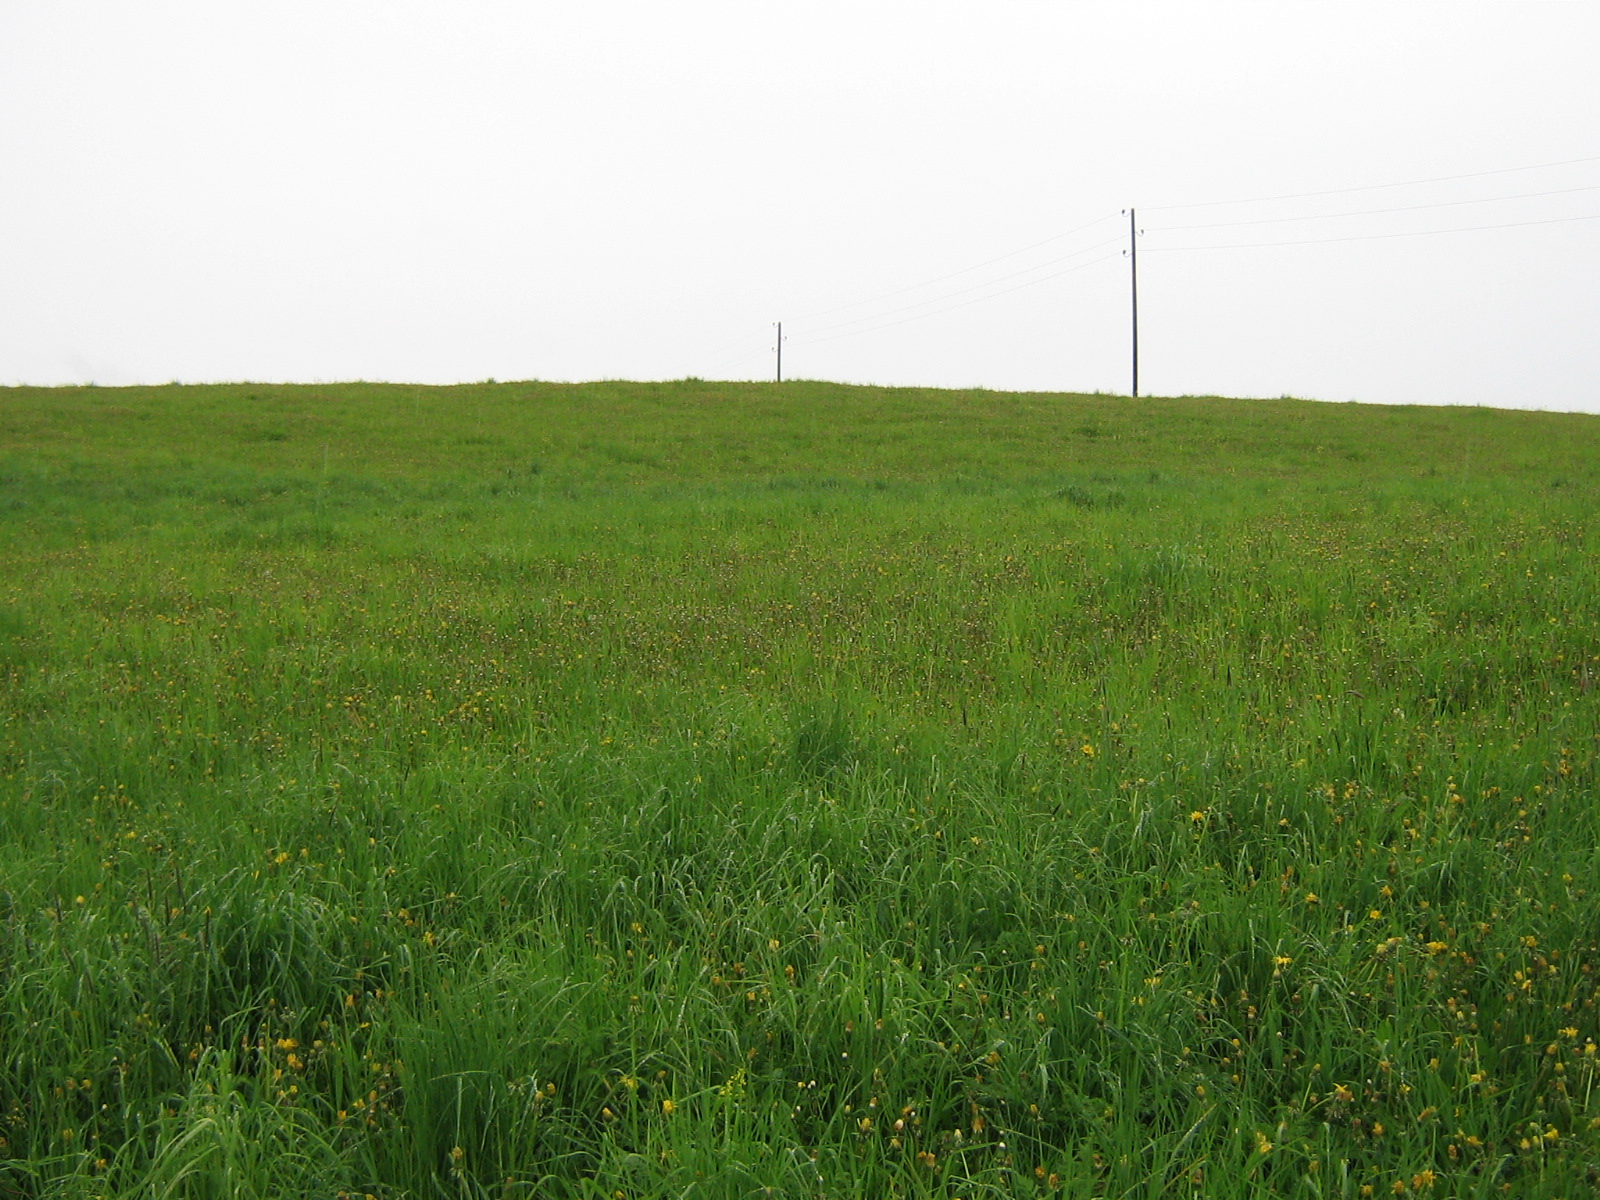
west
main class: Grassland
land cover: Grassland without tree/shrub cover
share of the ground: > 75 %
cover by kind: herbaceous plants 100 %
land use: Agriculture (excluding fallow land and kitchen gardens)
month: May
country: LV
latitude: 57.2563
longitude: 25.9595
